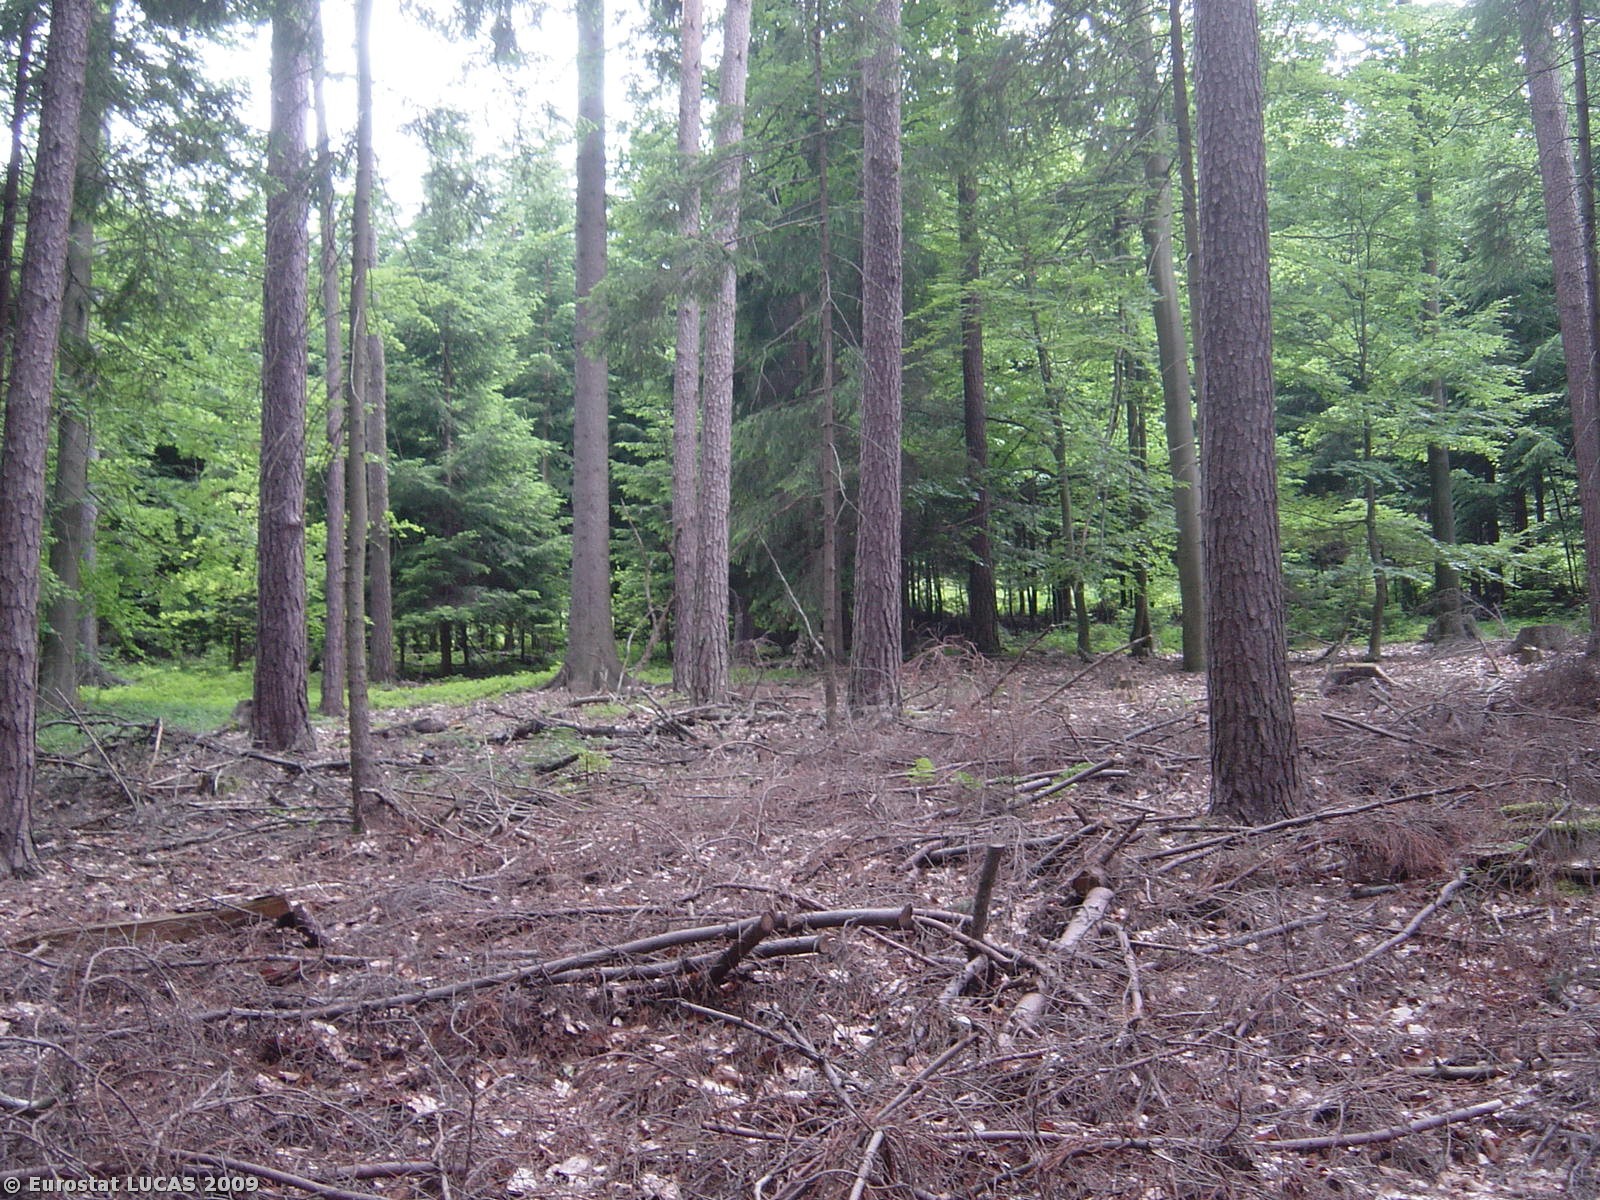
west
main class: Woodland
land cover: Mixed woodland
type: hemiboreal forest and nemoral coniferous forest and mixed broadleaved-coniferous forest
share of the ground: > 75 %
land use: Forestry
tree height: > 5 m
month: June
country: CZ
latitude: 49.8884
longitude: 16.5355
